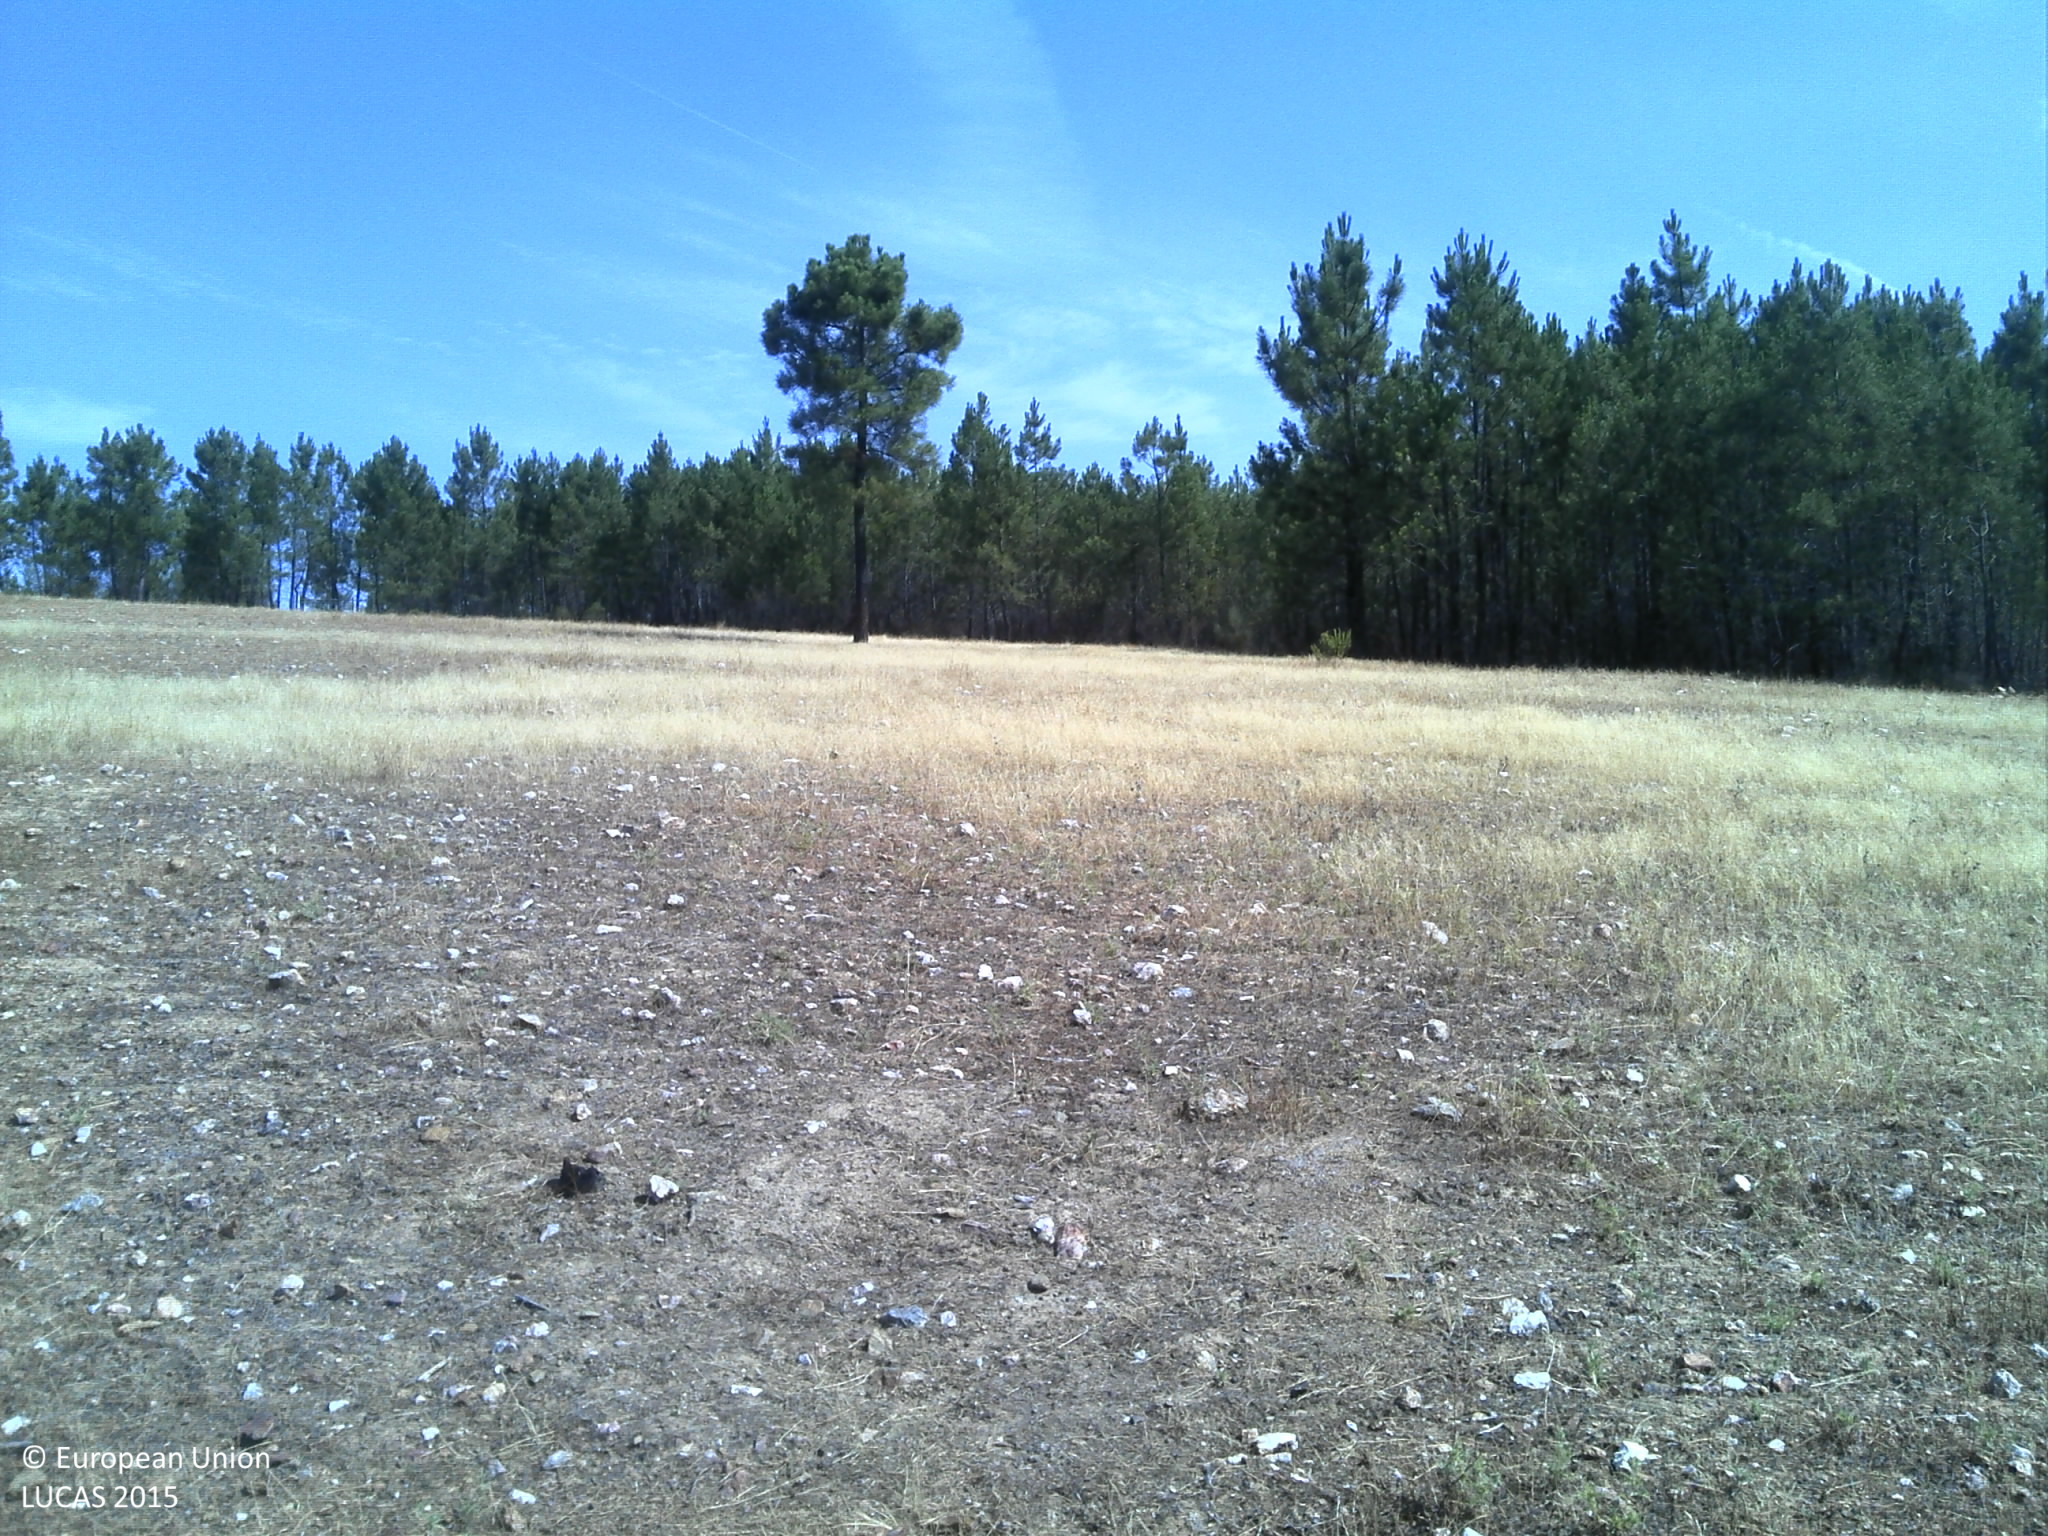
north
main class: Grassland
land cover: Grassland without tree/shrub cover
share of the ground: 25 - 50 %
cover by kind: unconsolidated bare surface 75 %, herbaceous plants 25 %
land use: Agriculture (excluding fallow land and kitchen gardens)
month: July
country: PT
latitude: 39.7523
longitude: -7.5954
